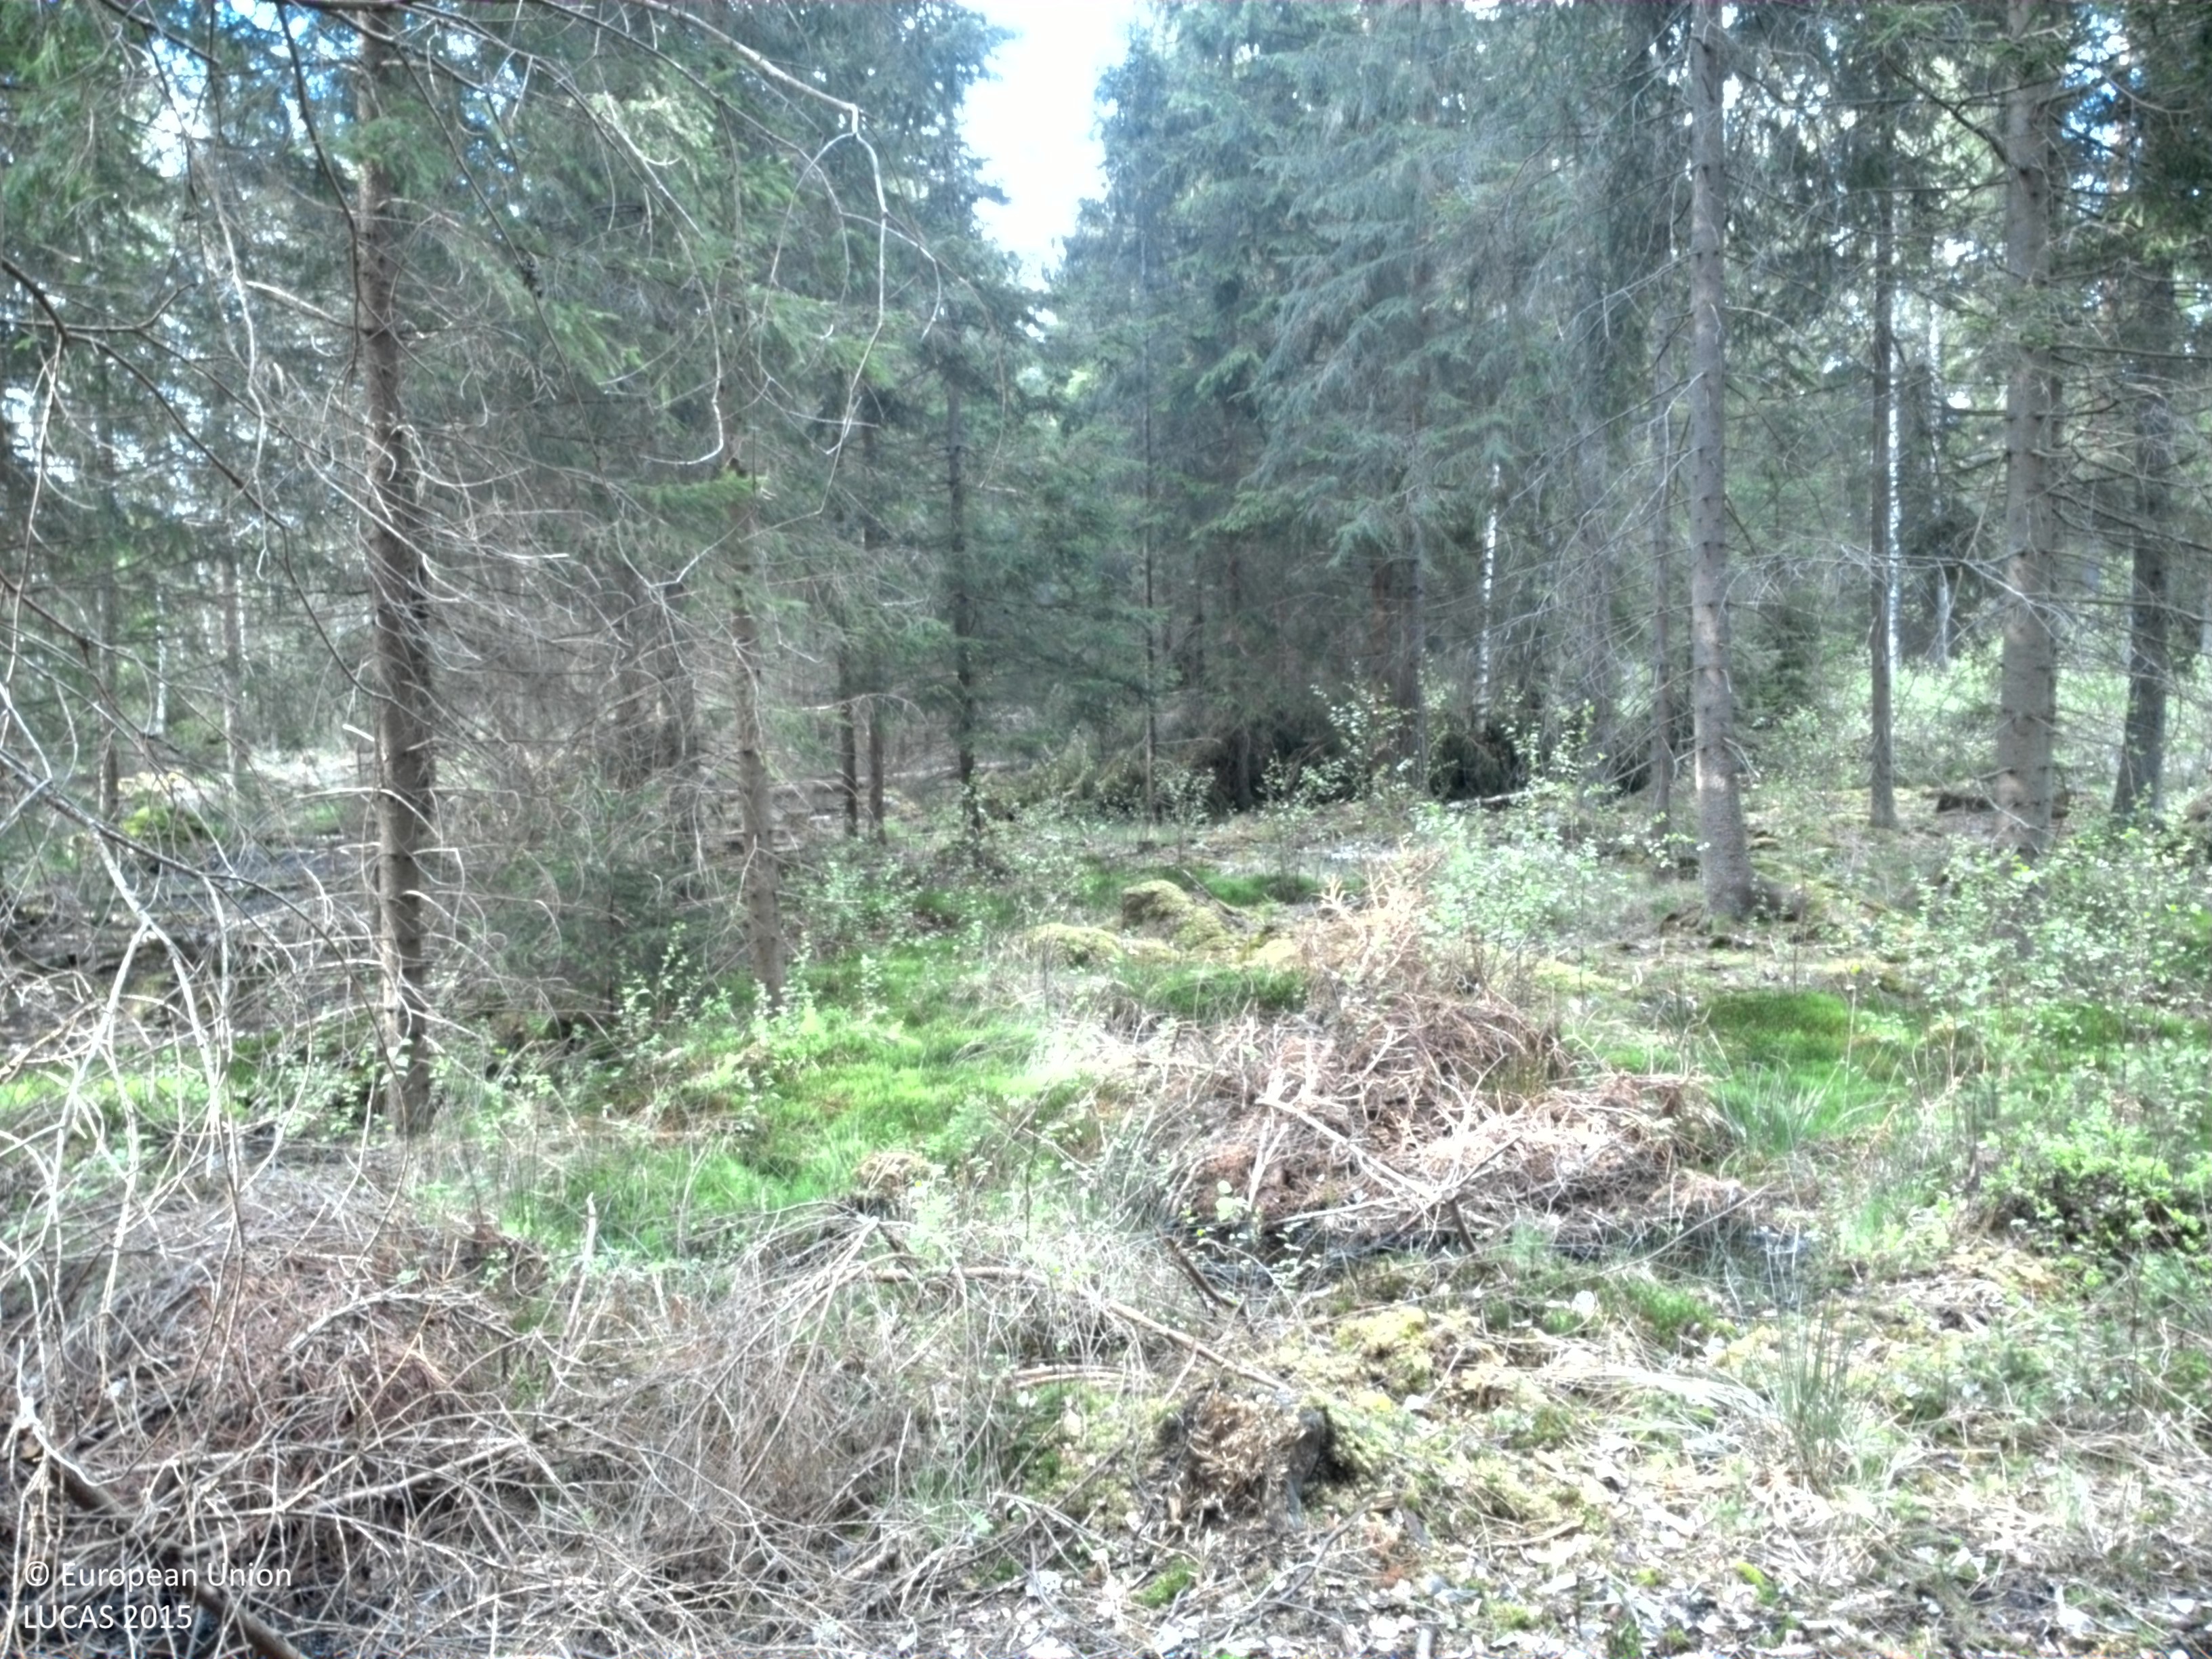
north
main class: Woodland
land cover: Spruce dominated coniferous woodland
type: boreal forest
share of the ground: > 75 %
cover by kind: coniferous forest trees 60 %, broadleaved forest trees 20 %, lichens and mosses 20 %
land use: Forestry
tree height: > 5 m
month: May
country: SE
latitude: 56.6464
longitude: 14.5799
